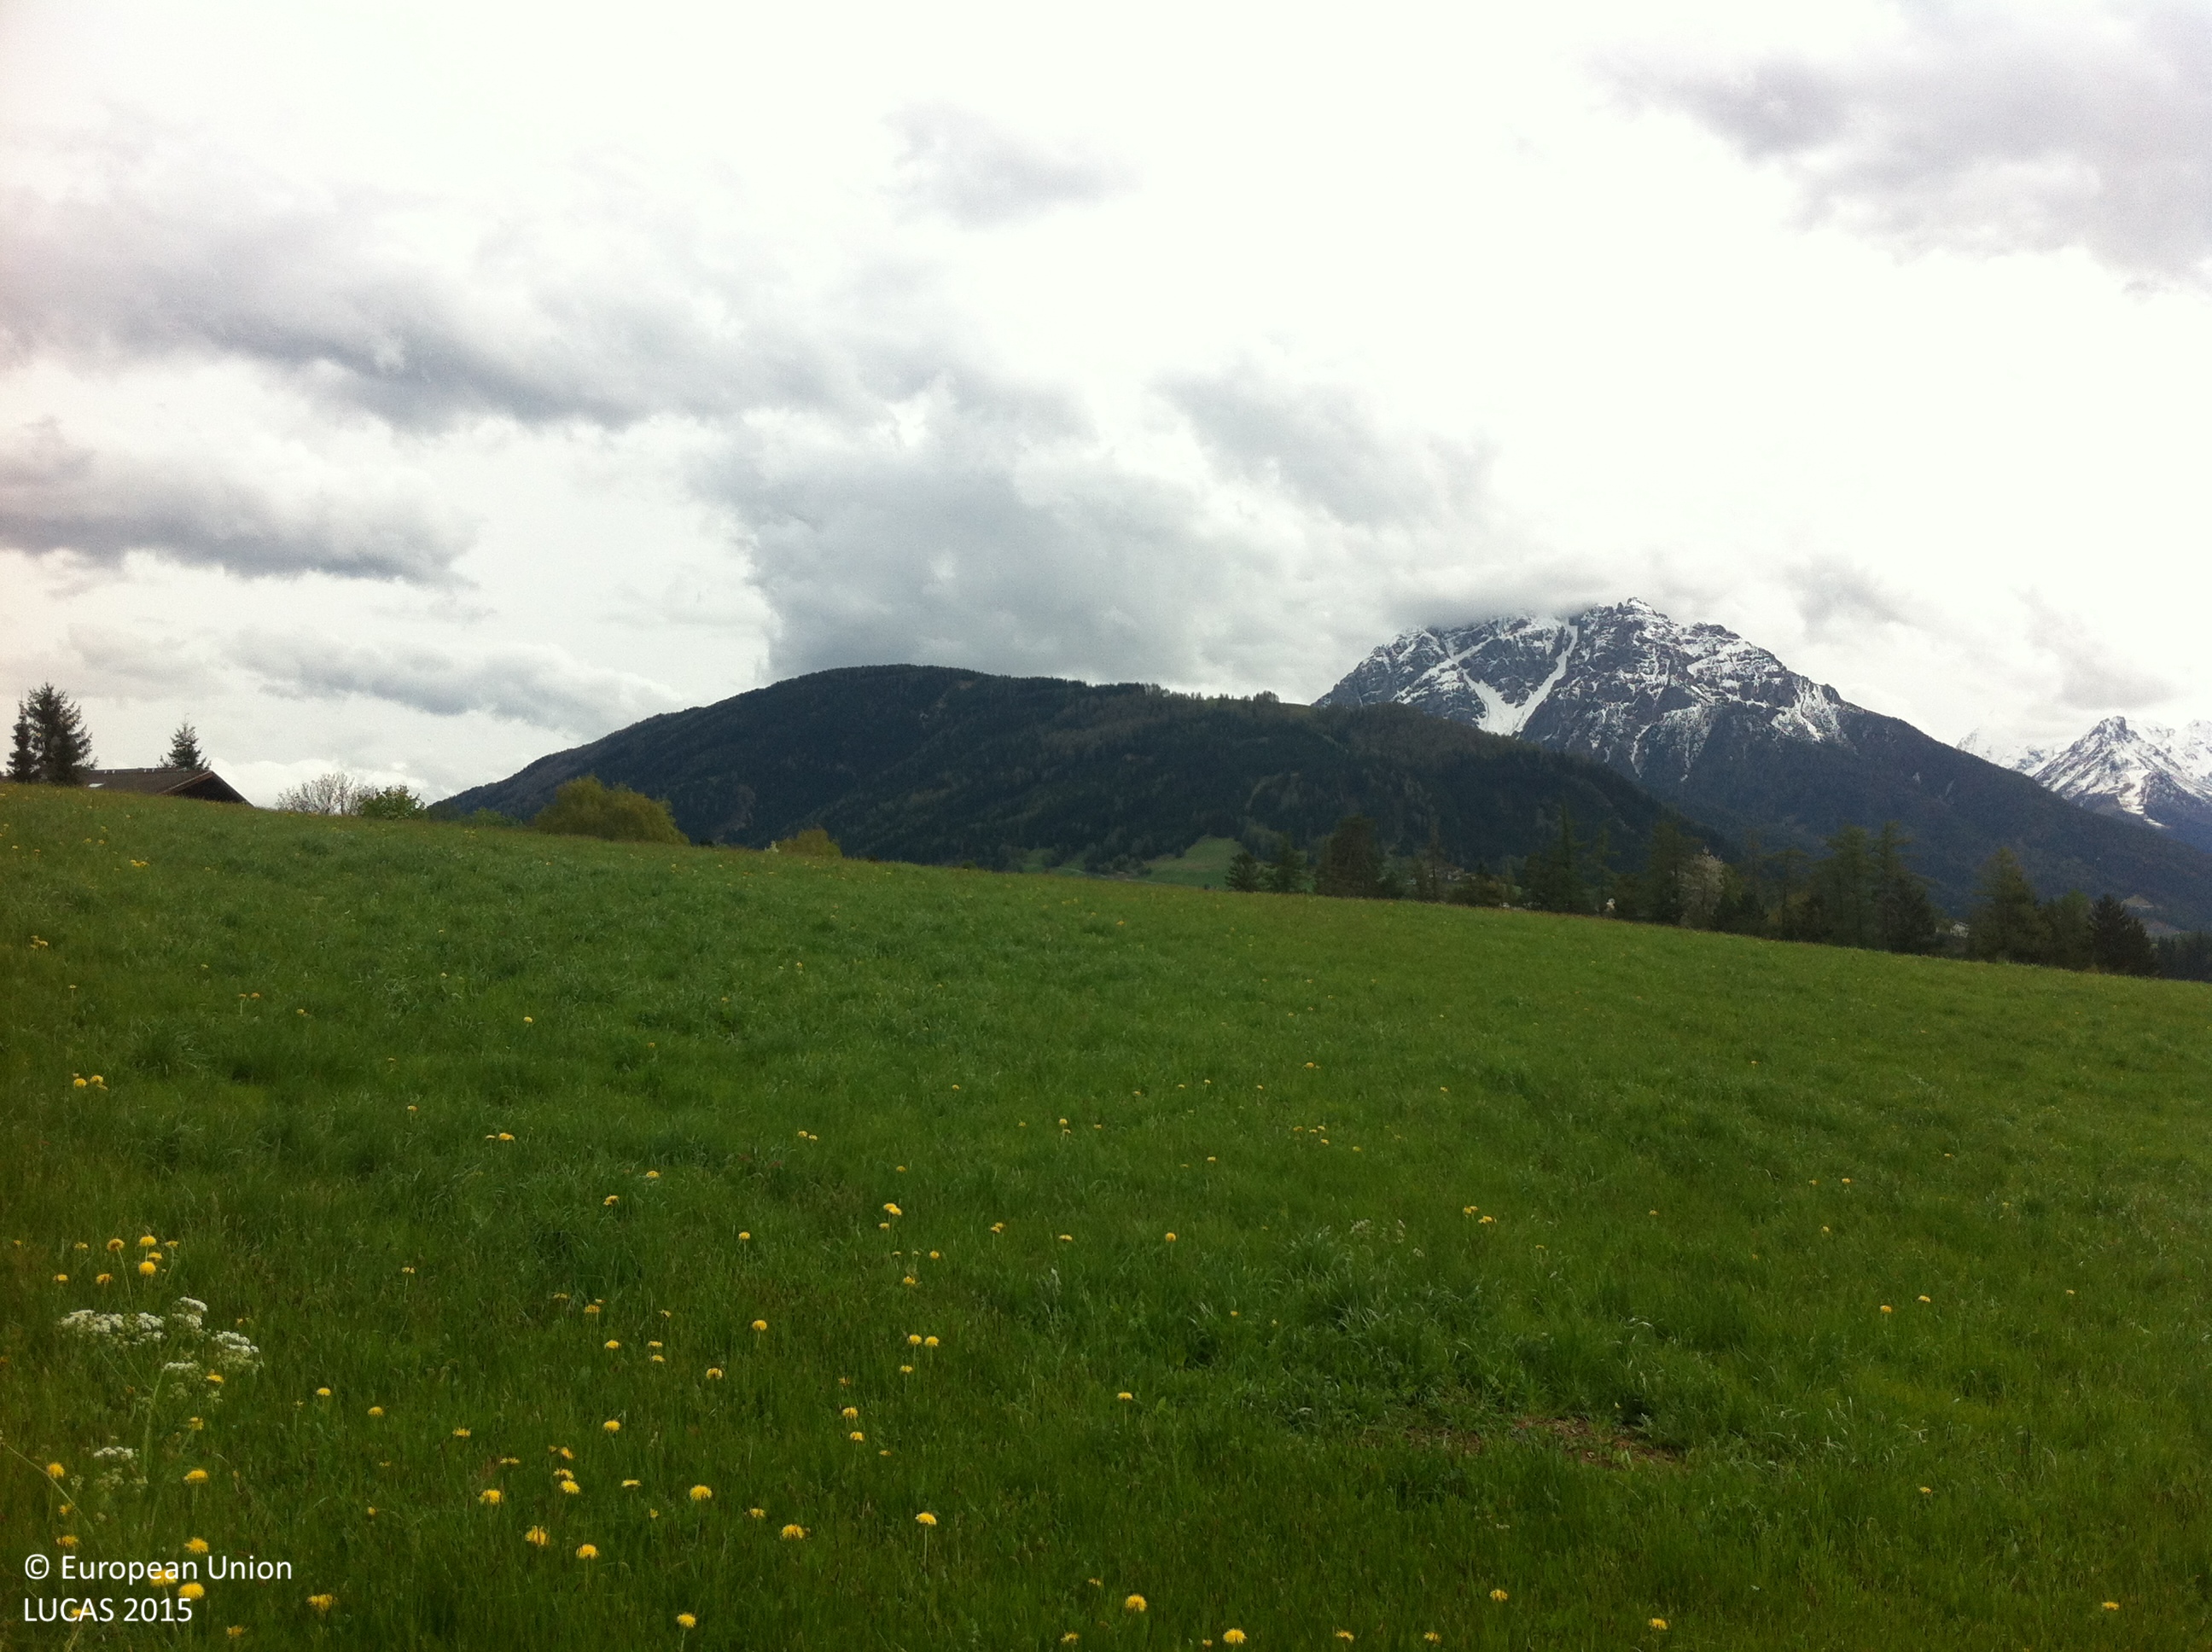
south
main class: Grassland
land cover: Grassland without tree/shrub cover
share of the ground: > 75 %
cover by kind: herbaceous plants 100 %
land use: Agriculture (excluding fallow land and kitchen gardens)
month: May
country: AT
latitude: 47.2064
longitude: 11.4113
